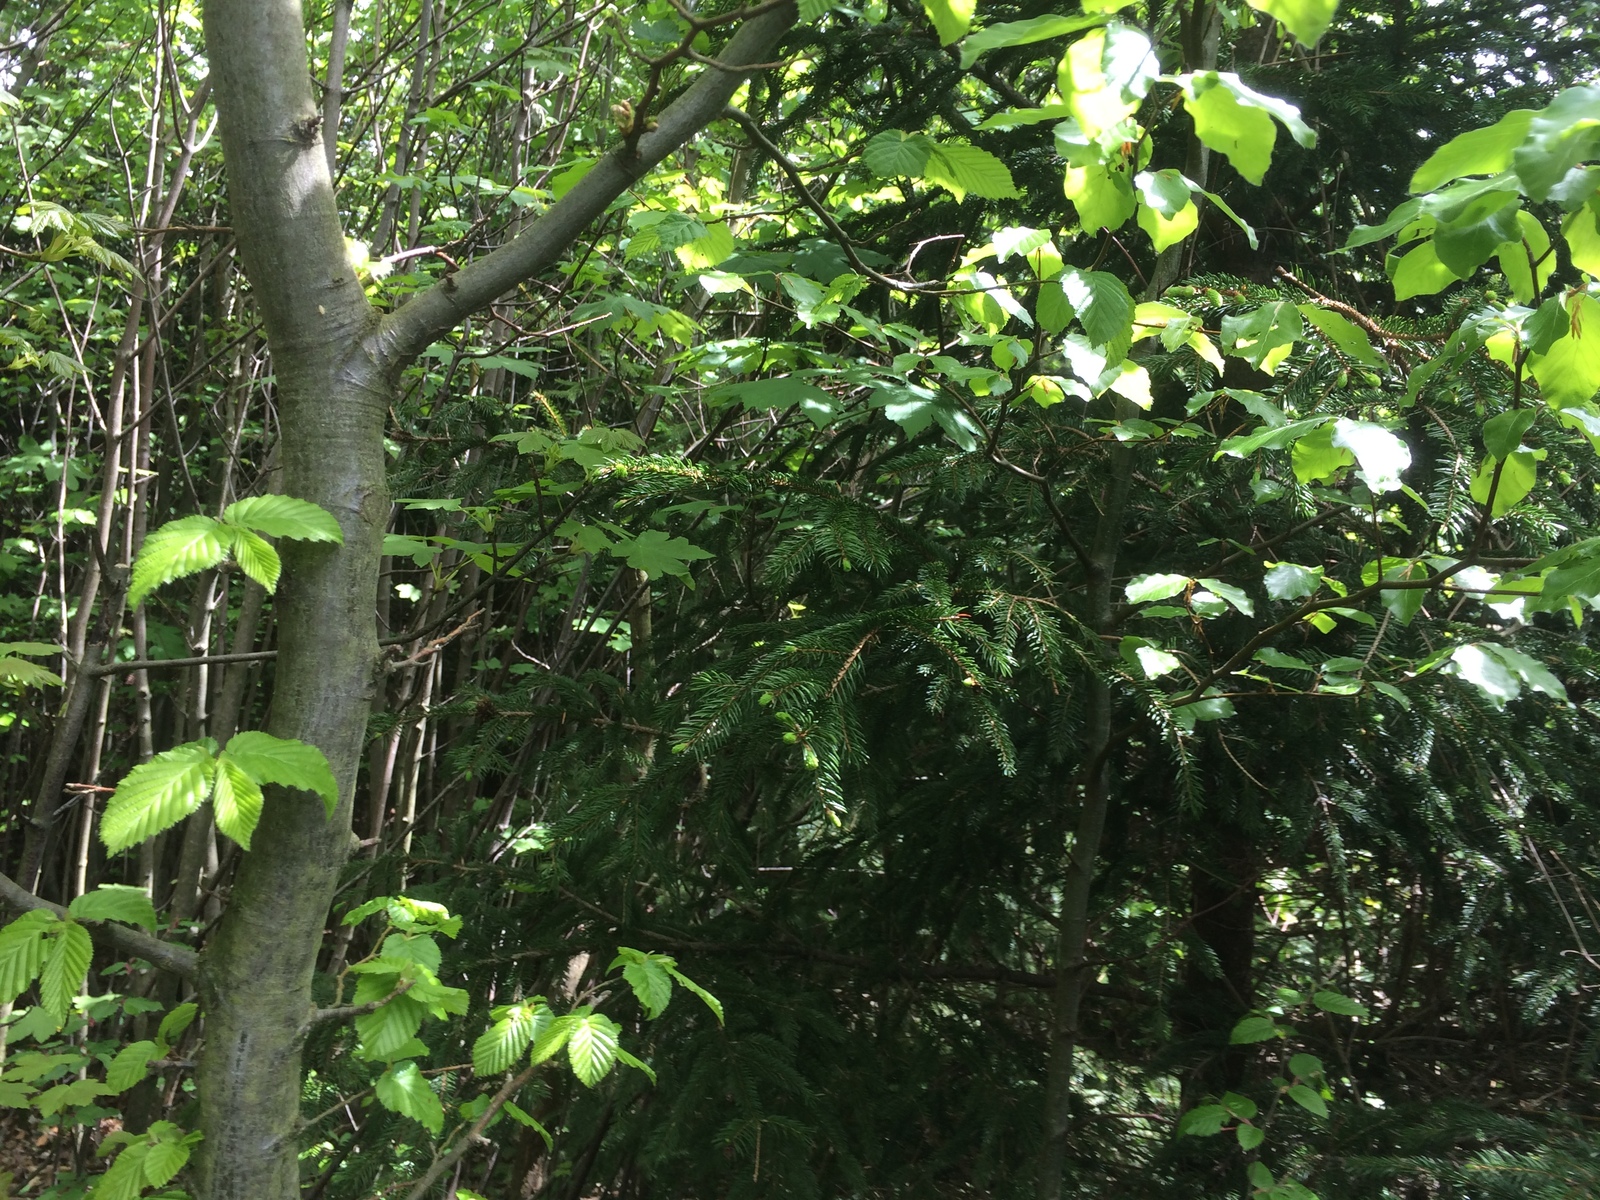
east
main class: Woodland
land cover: Spruce dominated mixed woodland
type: alpine coniferous forest
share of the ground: > 75 %
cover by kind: coniferous forest trees 45 %, broadleaved forest trees 45 %, herbaceous plants 10 %
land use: Forestry
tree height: > 5 m
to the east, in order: Spruce dominated mixed woodland; Spruce dominated coniferous woodland; Inland marshes; Broadleaved woodland; Ditches and canals; Broadleaved woodland; Spruce dominated coniferous woodland; Inland marshes; Spruce dominated coniferous woodland
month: May
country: AT
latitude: 48.0915
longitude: 16.0859
